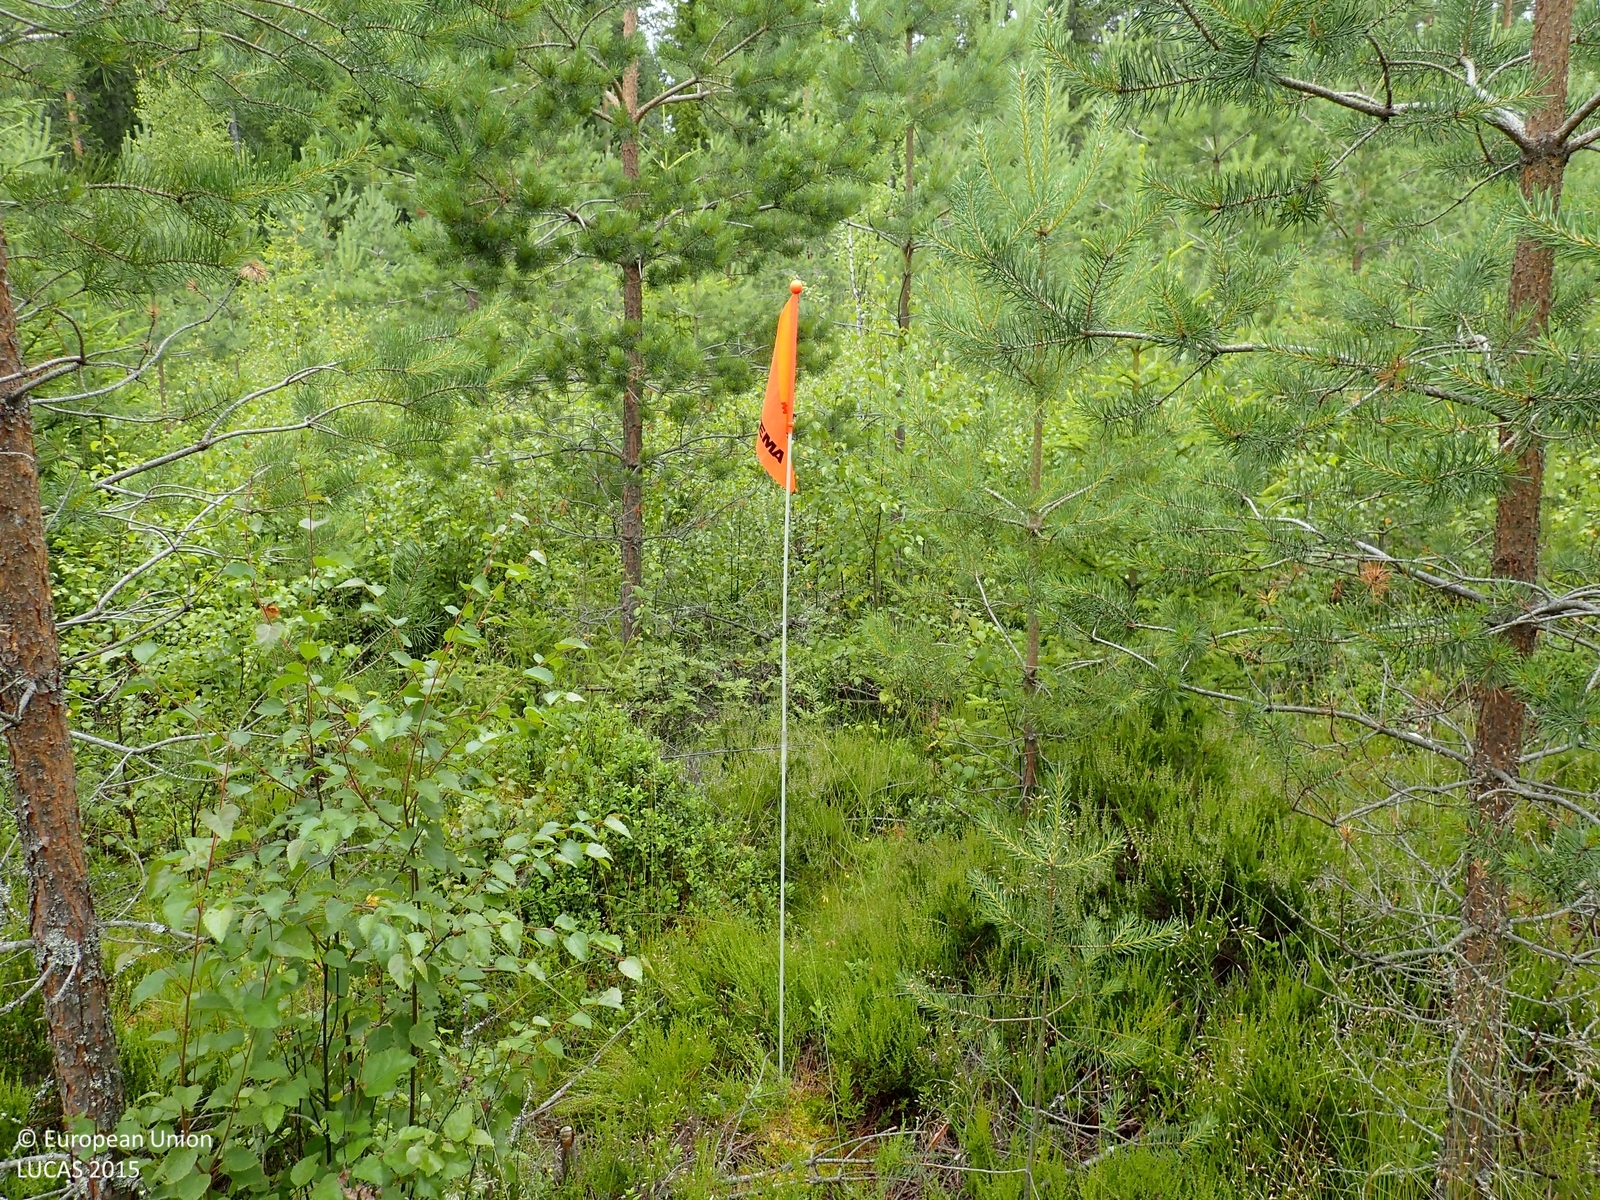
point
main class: Woodland
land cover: Pine dominated mixed woodland
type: boreal forest
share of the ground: > 75 %
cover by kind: coniferous forest trees 55 %, shrubs 25 %, broadleaved forest trees 20 %
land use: Forestry
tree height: < 5 m
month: July
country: FI
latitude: 62.8810
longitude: 23.2981
